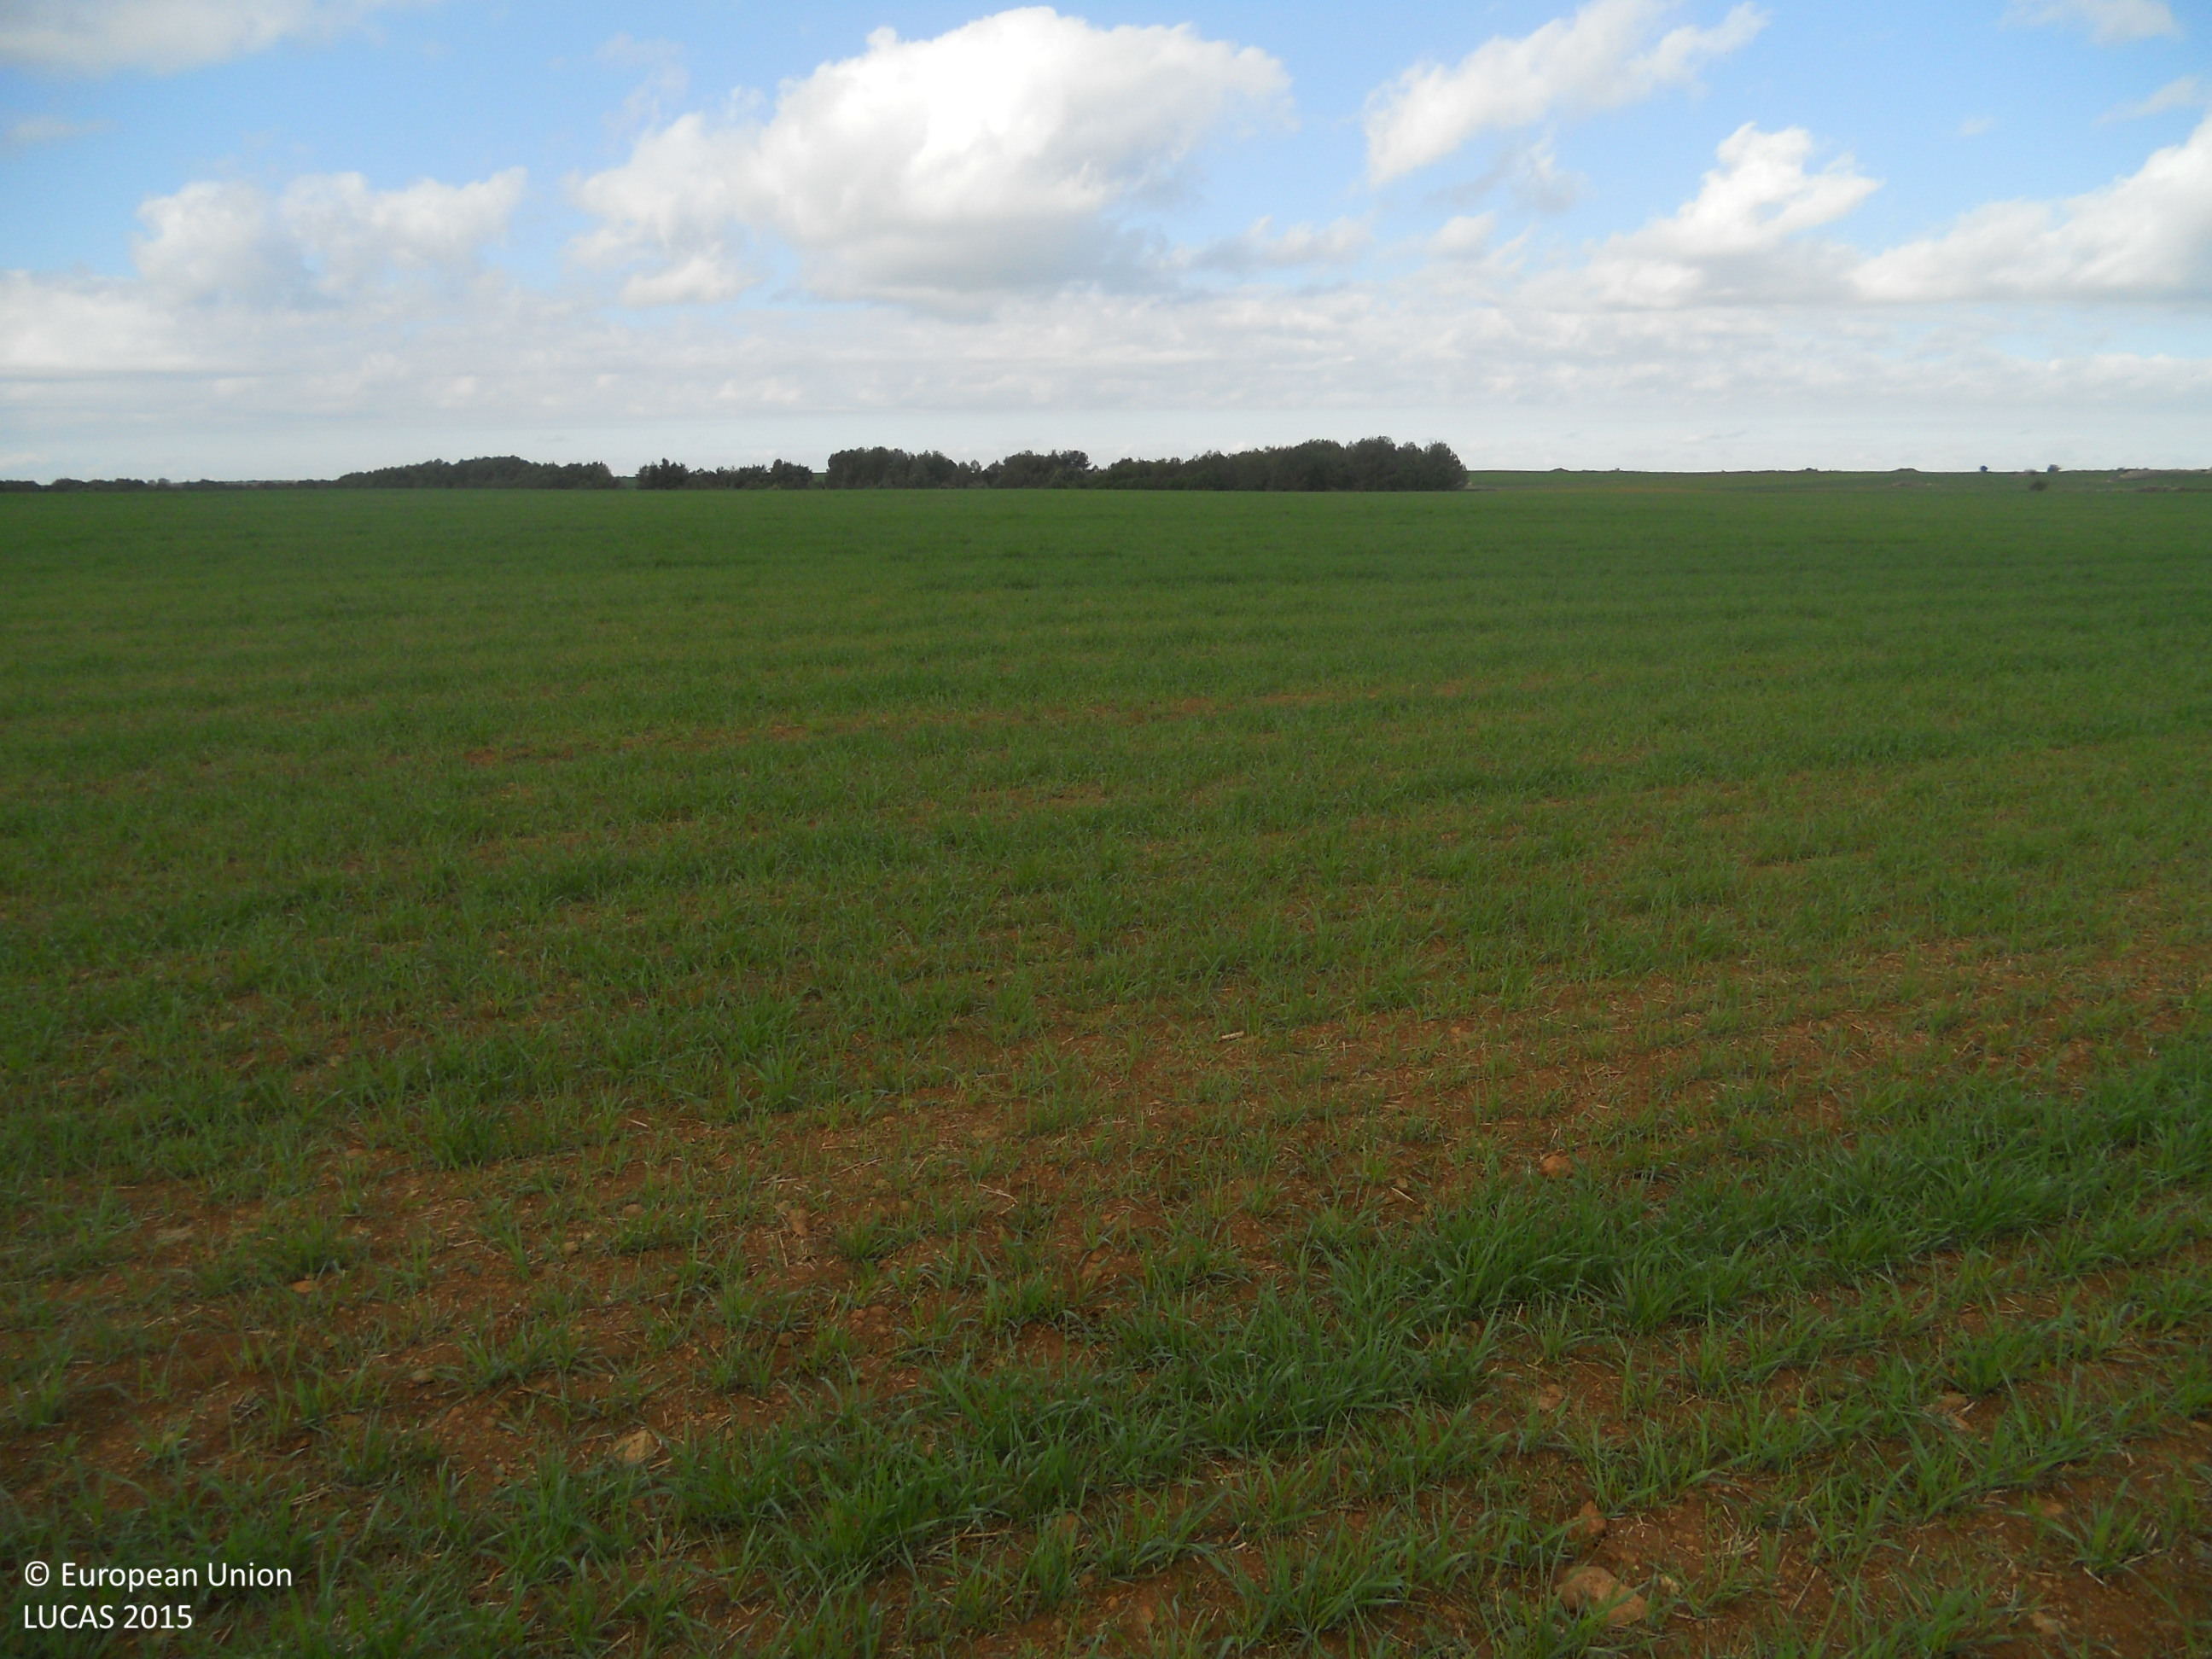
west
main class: Cropland
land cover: Barley
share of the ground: > 75 %
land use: Agriculture (excluding fallow land and kitchen gardens)
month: April
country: ES
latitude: 42.1767
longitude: -4.3423
